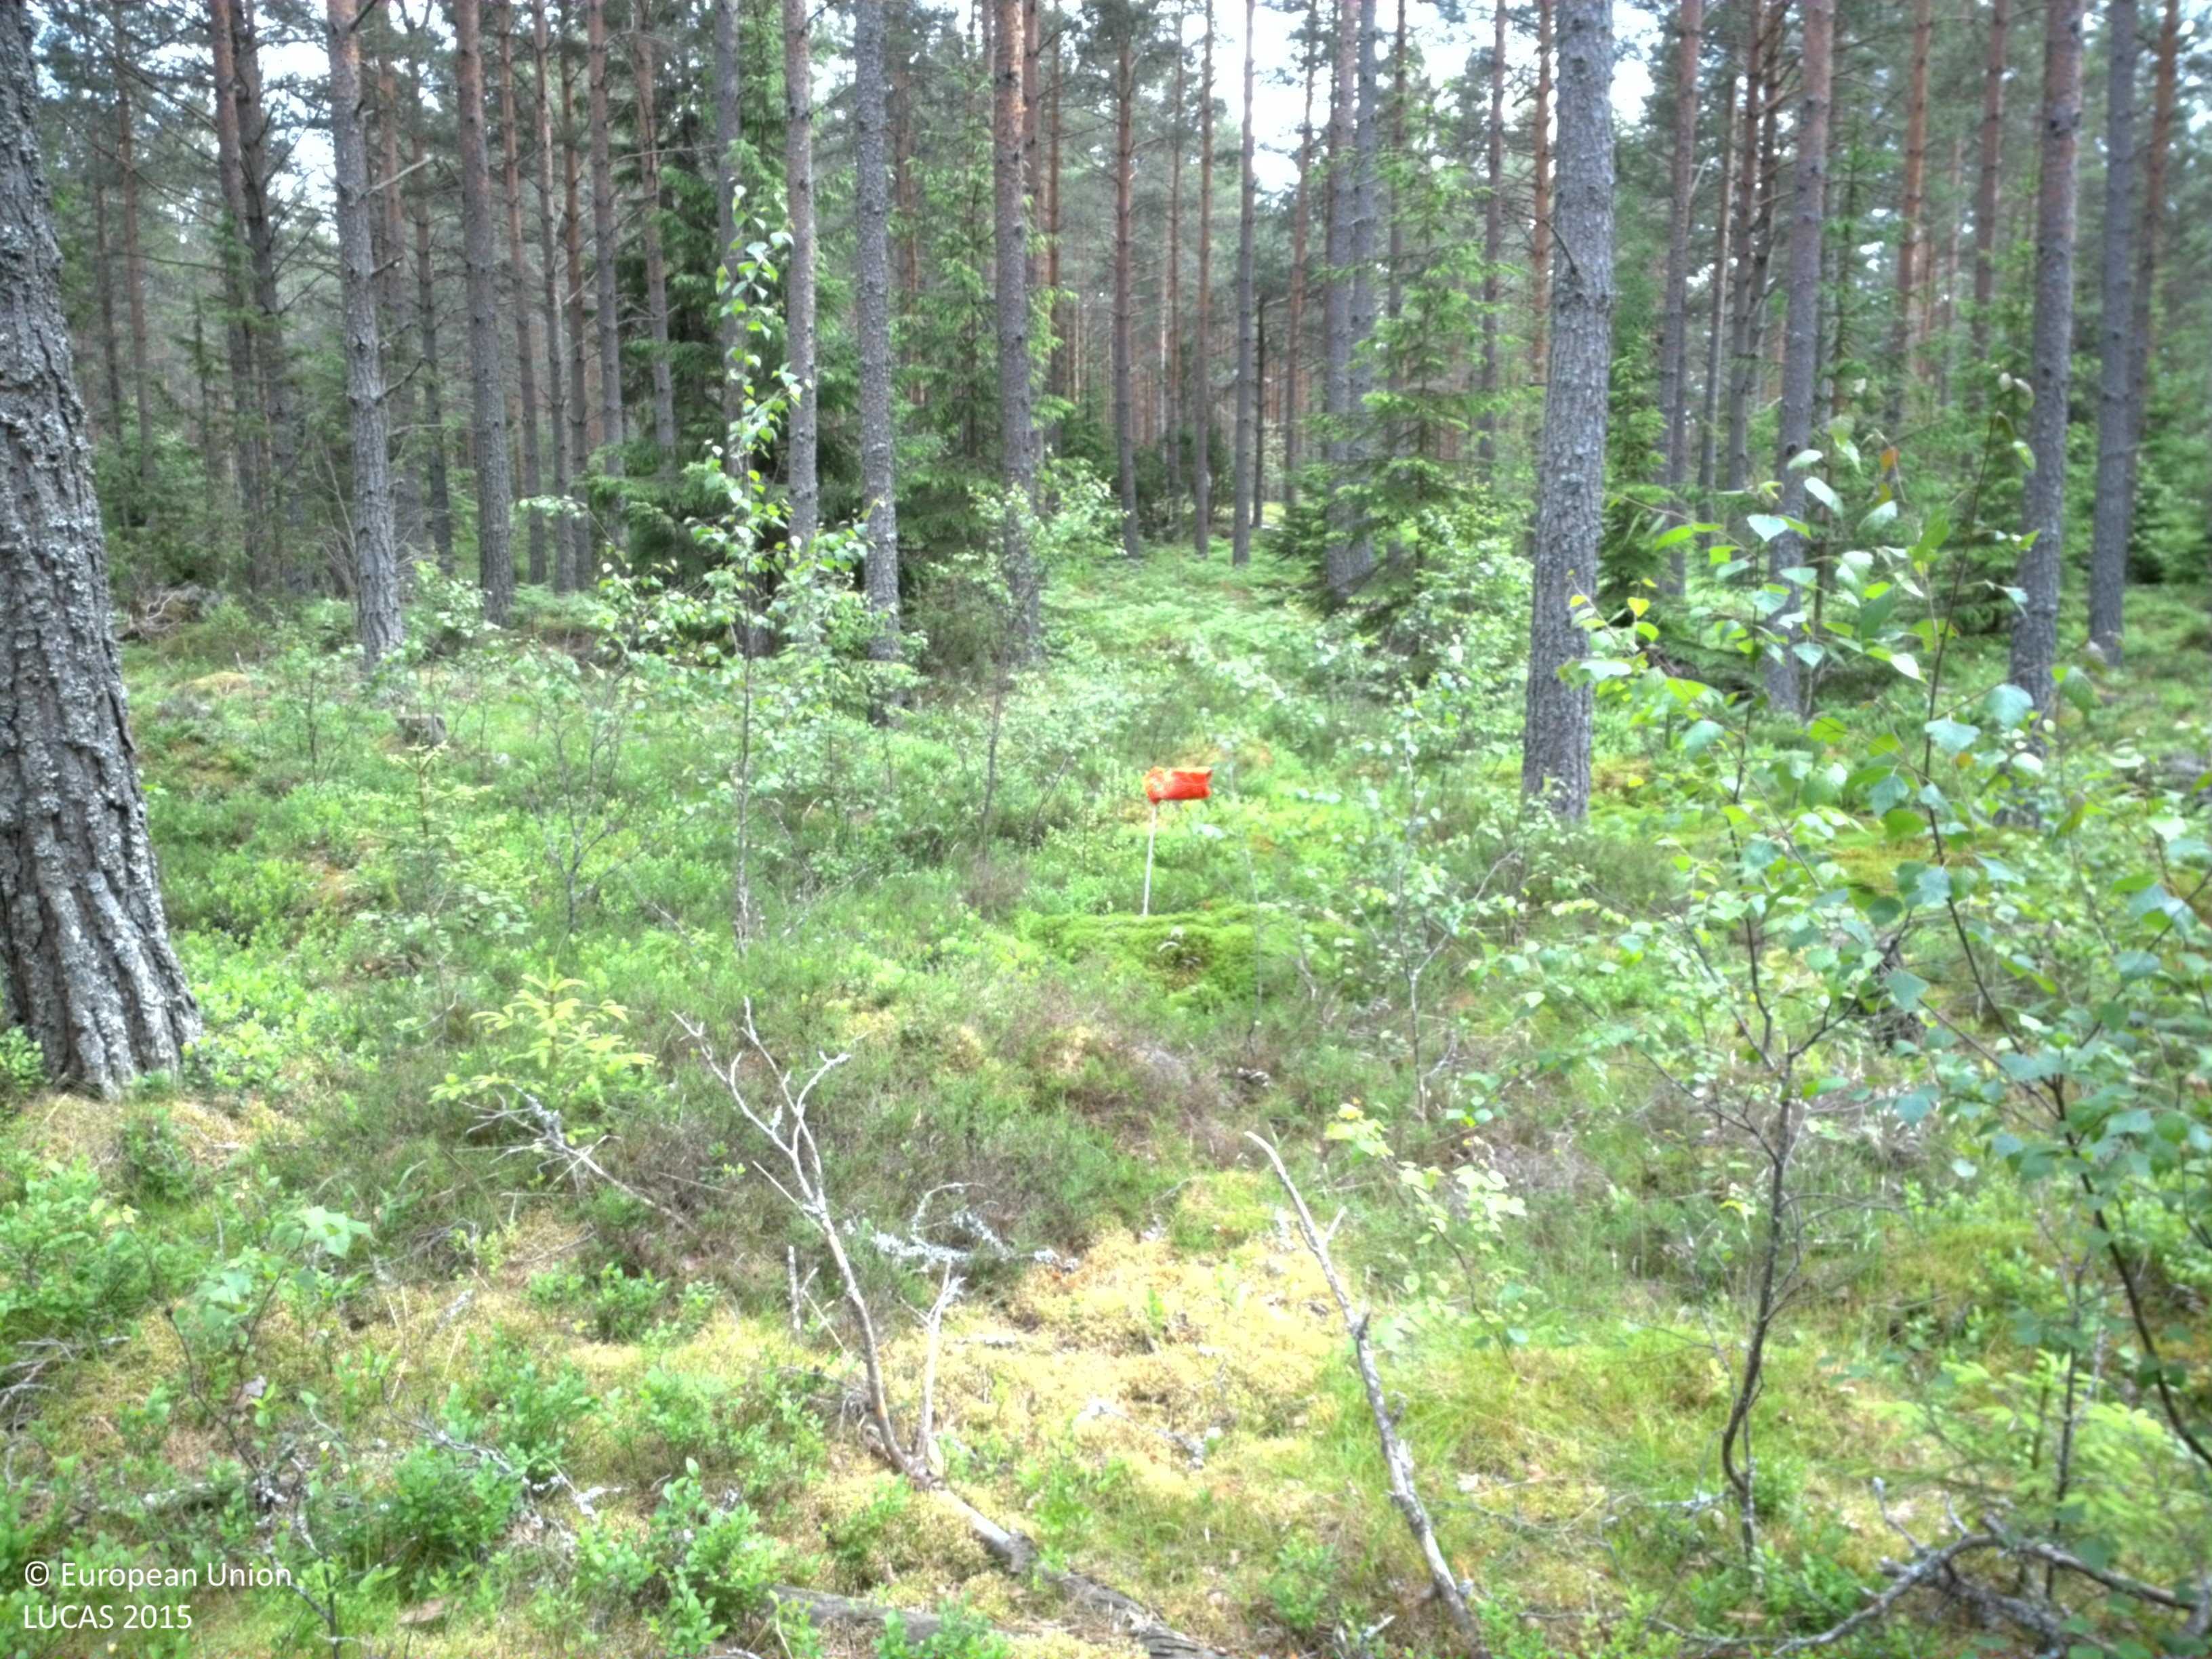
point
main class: Woodland
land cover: Pine dominated coniferous woodland
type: boreal forest
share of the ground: 10 - 25 %
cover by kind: herbaceous plants 35 %, lichens and mosses 35 %, coniferous forest trees 20 %, broadleaved forest trees 5 %, shrubs 5 %
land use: Forestry
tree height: > 5 m
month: June
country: SE
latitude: 58.7008
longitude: 15.5334
